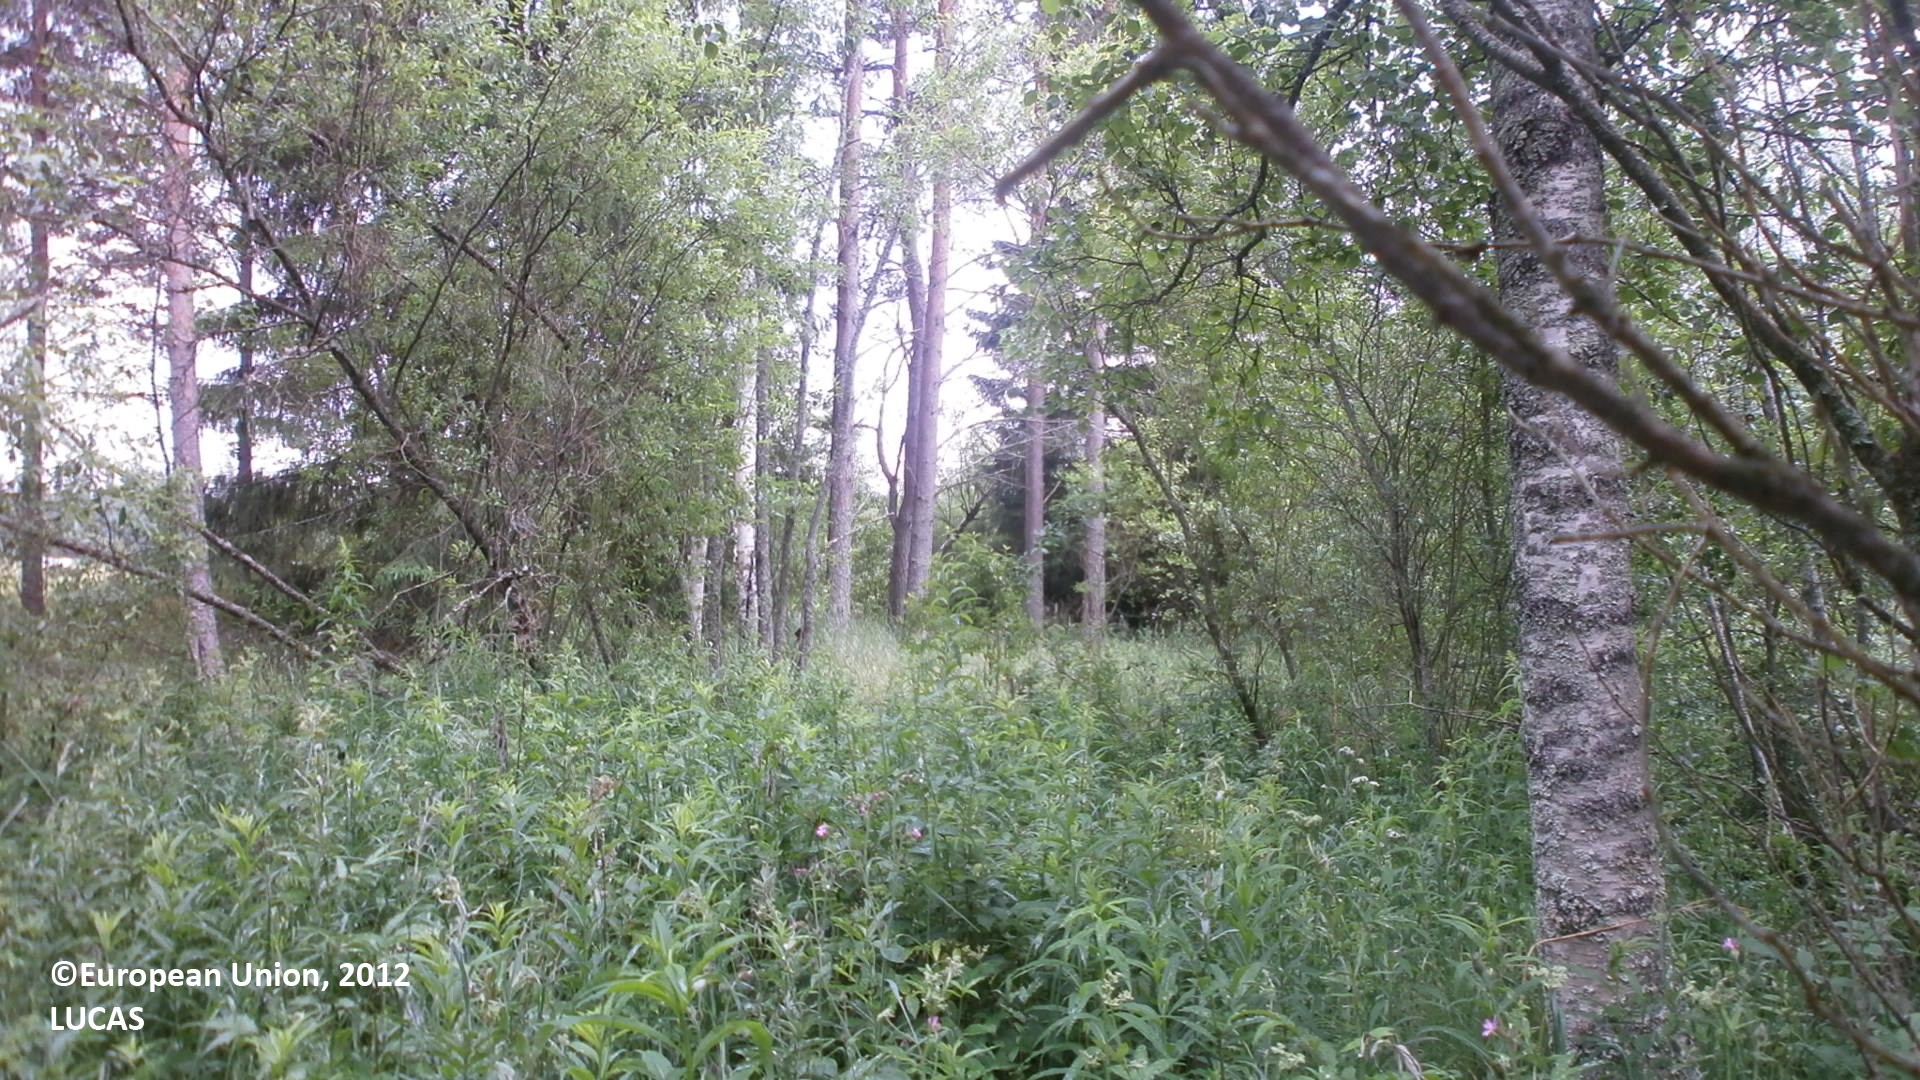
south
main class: Woodland
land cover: Spruce dominated mixed woodland
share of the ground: 50 - 75 %
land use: Forestry
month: July
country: FI
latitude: 64.6601
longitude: 24.5810
